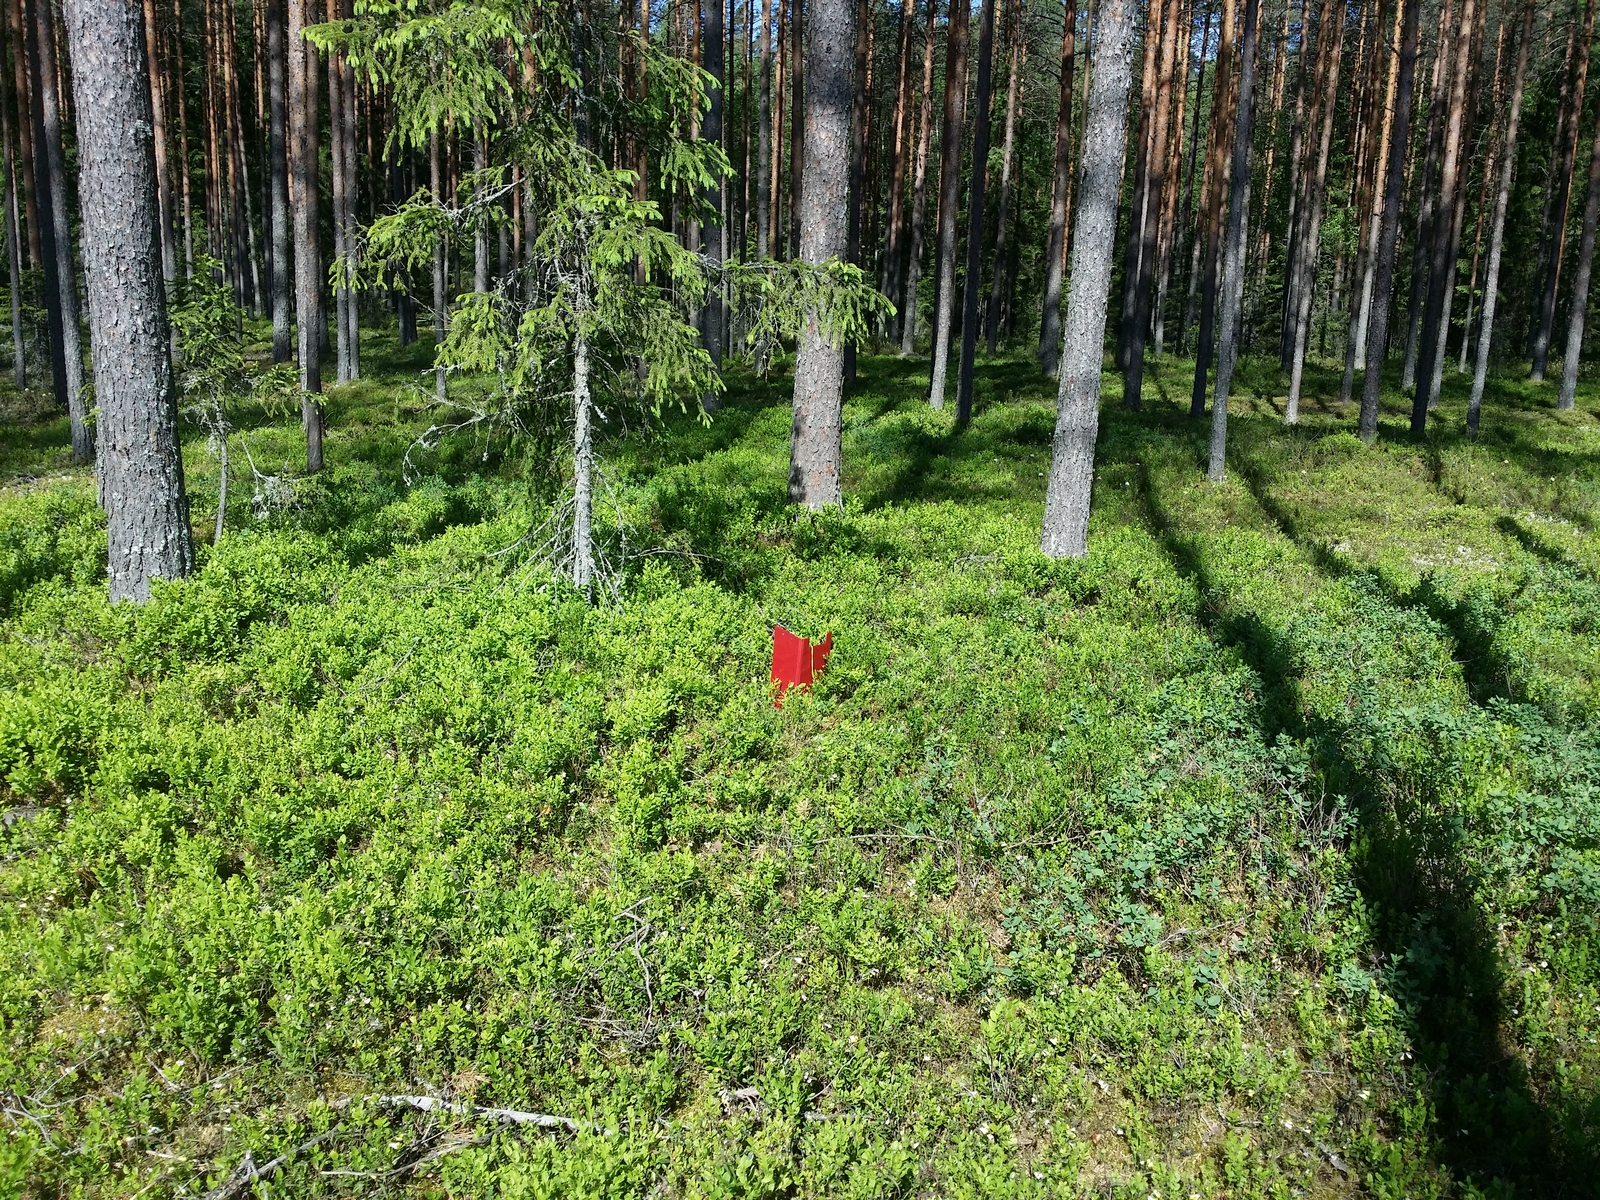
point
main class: Woodland
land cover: Pine dominated coniferous woodland
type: hemiboreal forest and nemoral coniferous forest and mixed broadleaved-coniferous forest
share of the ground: 50 - 75 %
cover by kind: coniferous forest trees 60 %, shrubs 20 %, herbaceous plants 10 %, lichens and mosses 10 %
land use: Forestry
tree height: > 5 m
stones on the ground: < 10 %
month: June
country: LV
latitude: 57.3483
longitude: 26.5471
